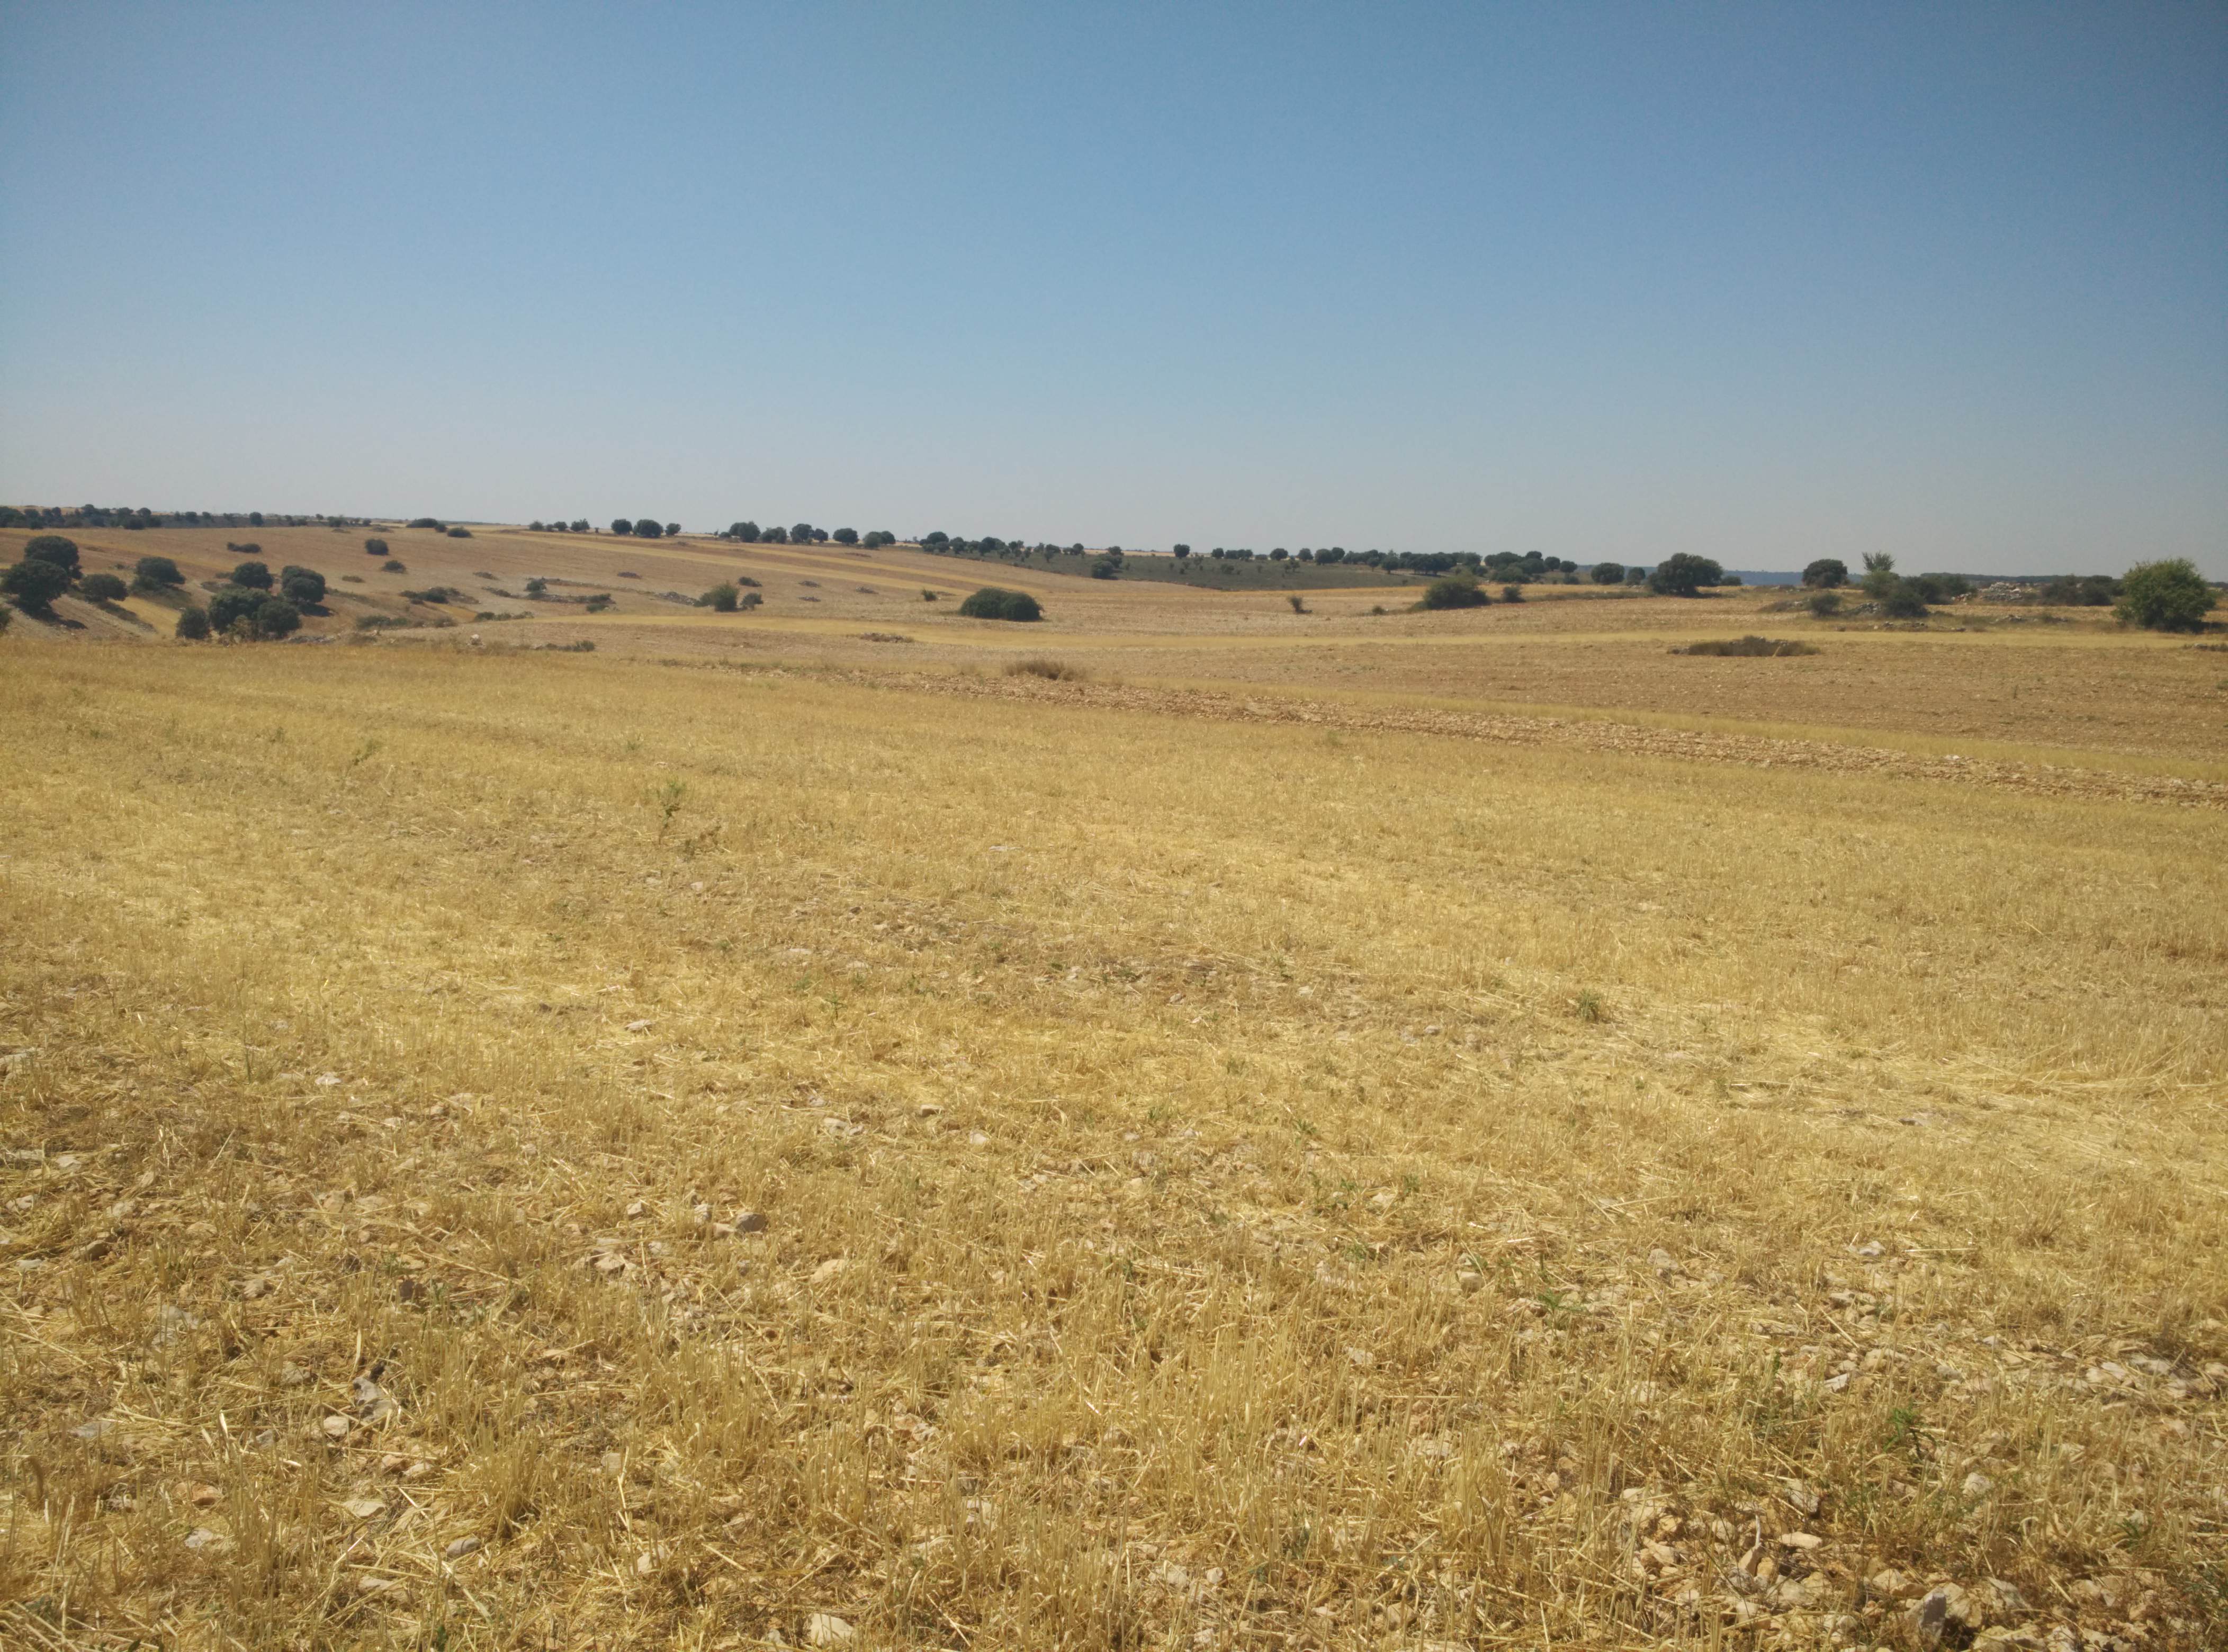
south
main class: Cropland
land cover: Barley
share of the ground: < 10 %
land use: Agriculture (excluding fallow land and kitchen gardens)
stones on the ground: > 50 %
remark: Harvested field
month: July
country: ES
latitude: 40.9127
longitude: -2.8917
